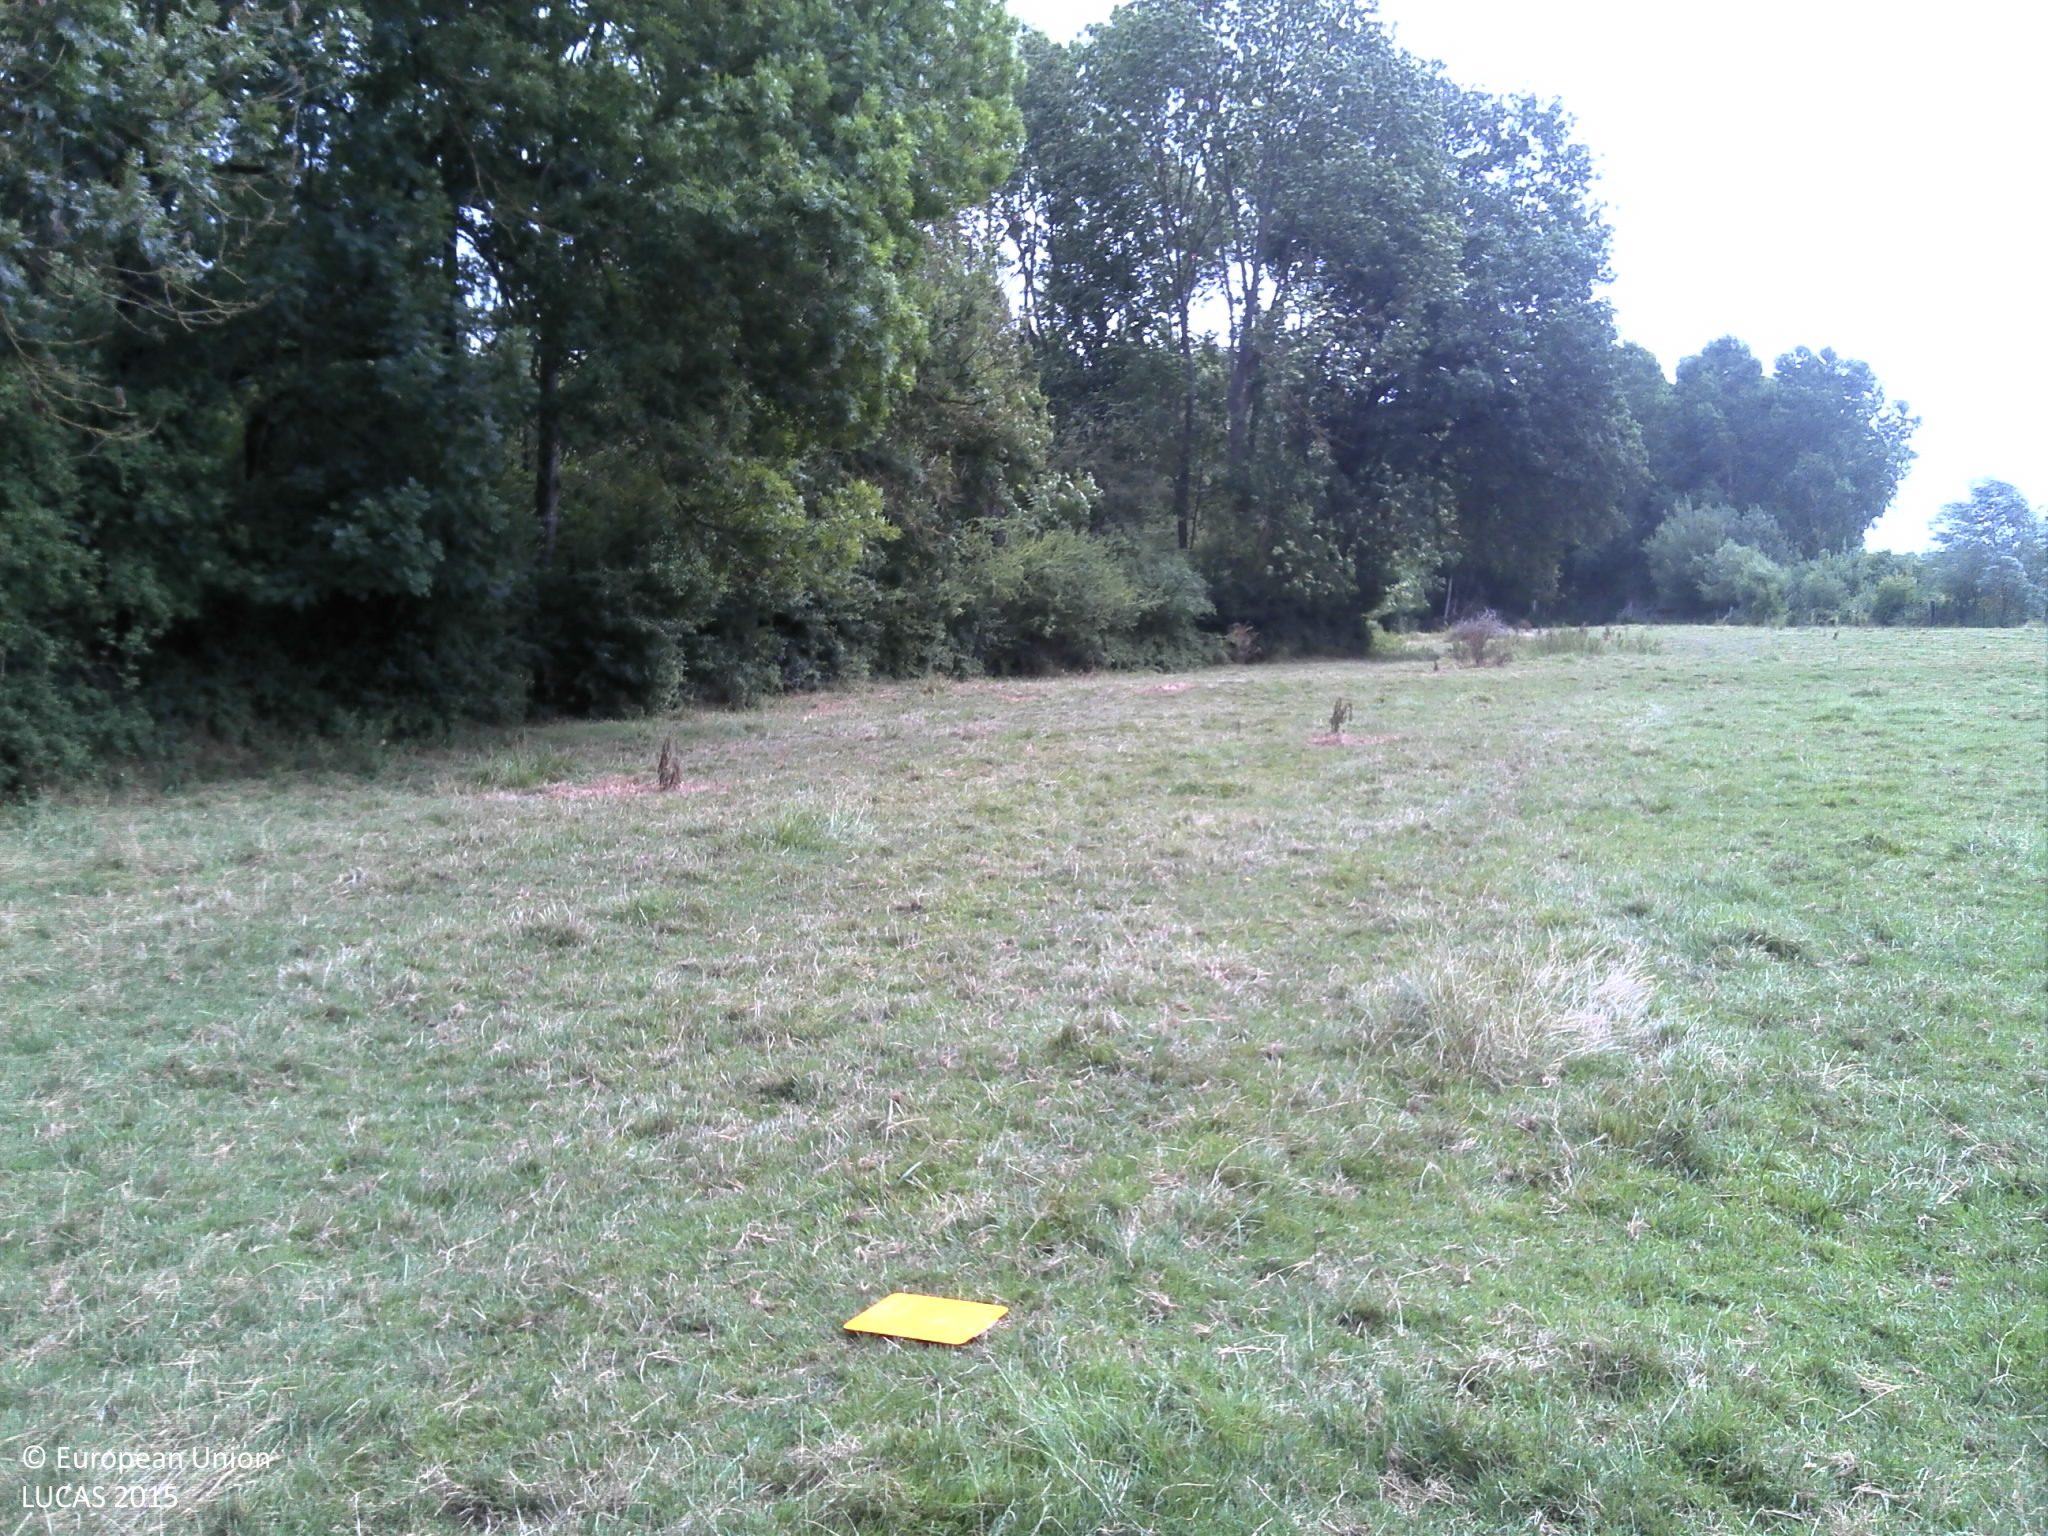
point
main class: Grassland
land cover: Grassland without tree/shrub cover
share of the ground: > 75 %
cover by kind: herbaceous plants 100 %
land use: Agriculture (excluding fallow land and kitchen gardens)
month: July
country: FR
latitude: 49.4104
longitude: 4.6628
